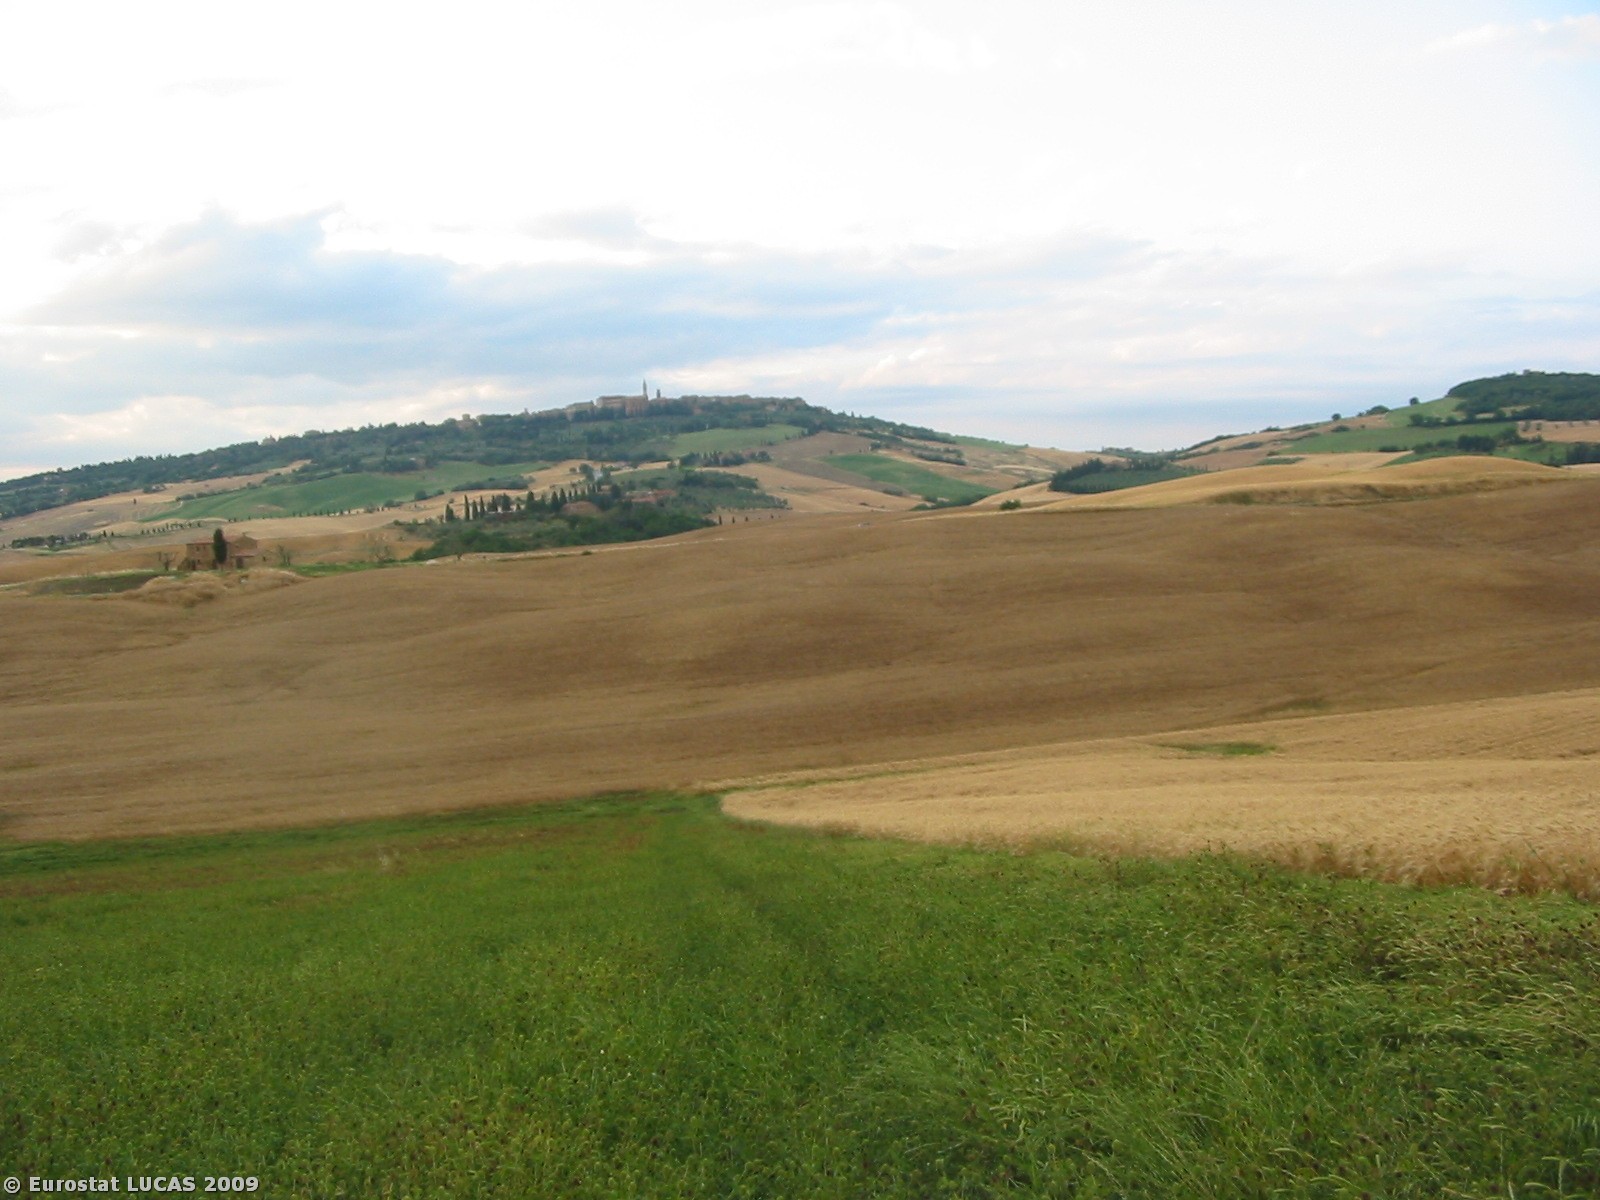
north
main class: Cropland
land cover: Clovers
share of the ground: > 75 %
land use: Agriculture (excluding fallow land and kitchen gardens)
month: June
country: IT
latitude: 43.0555
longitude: 11.6770
